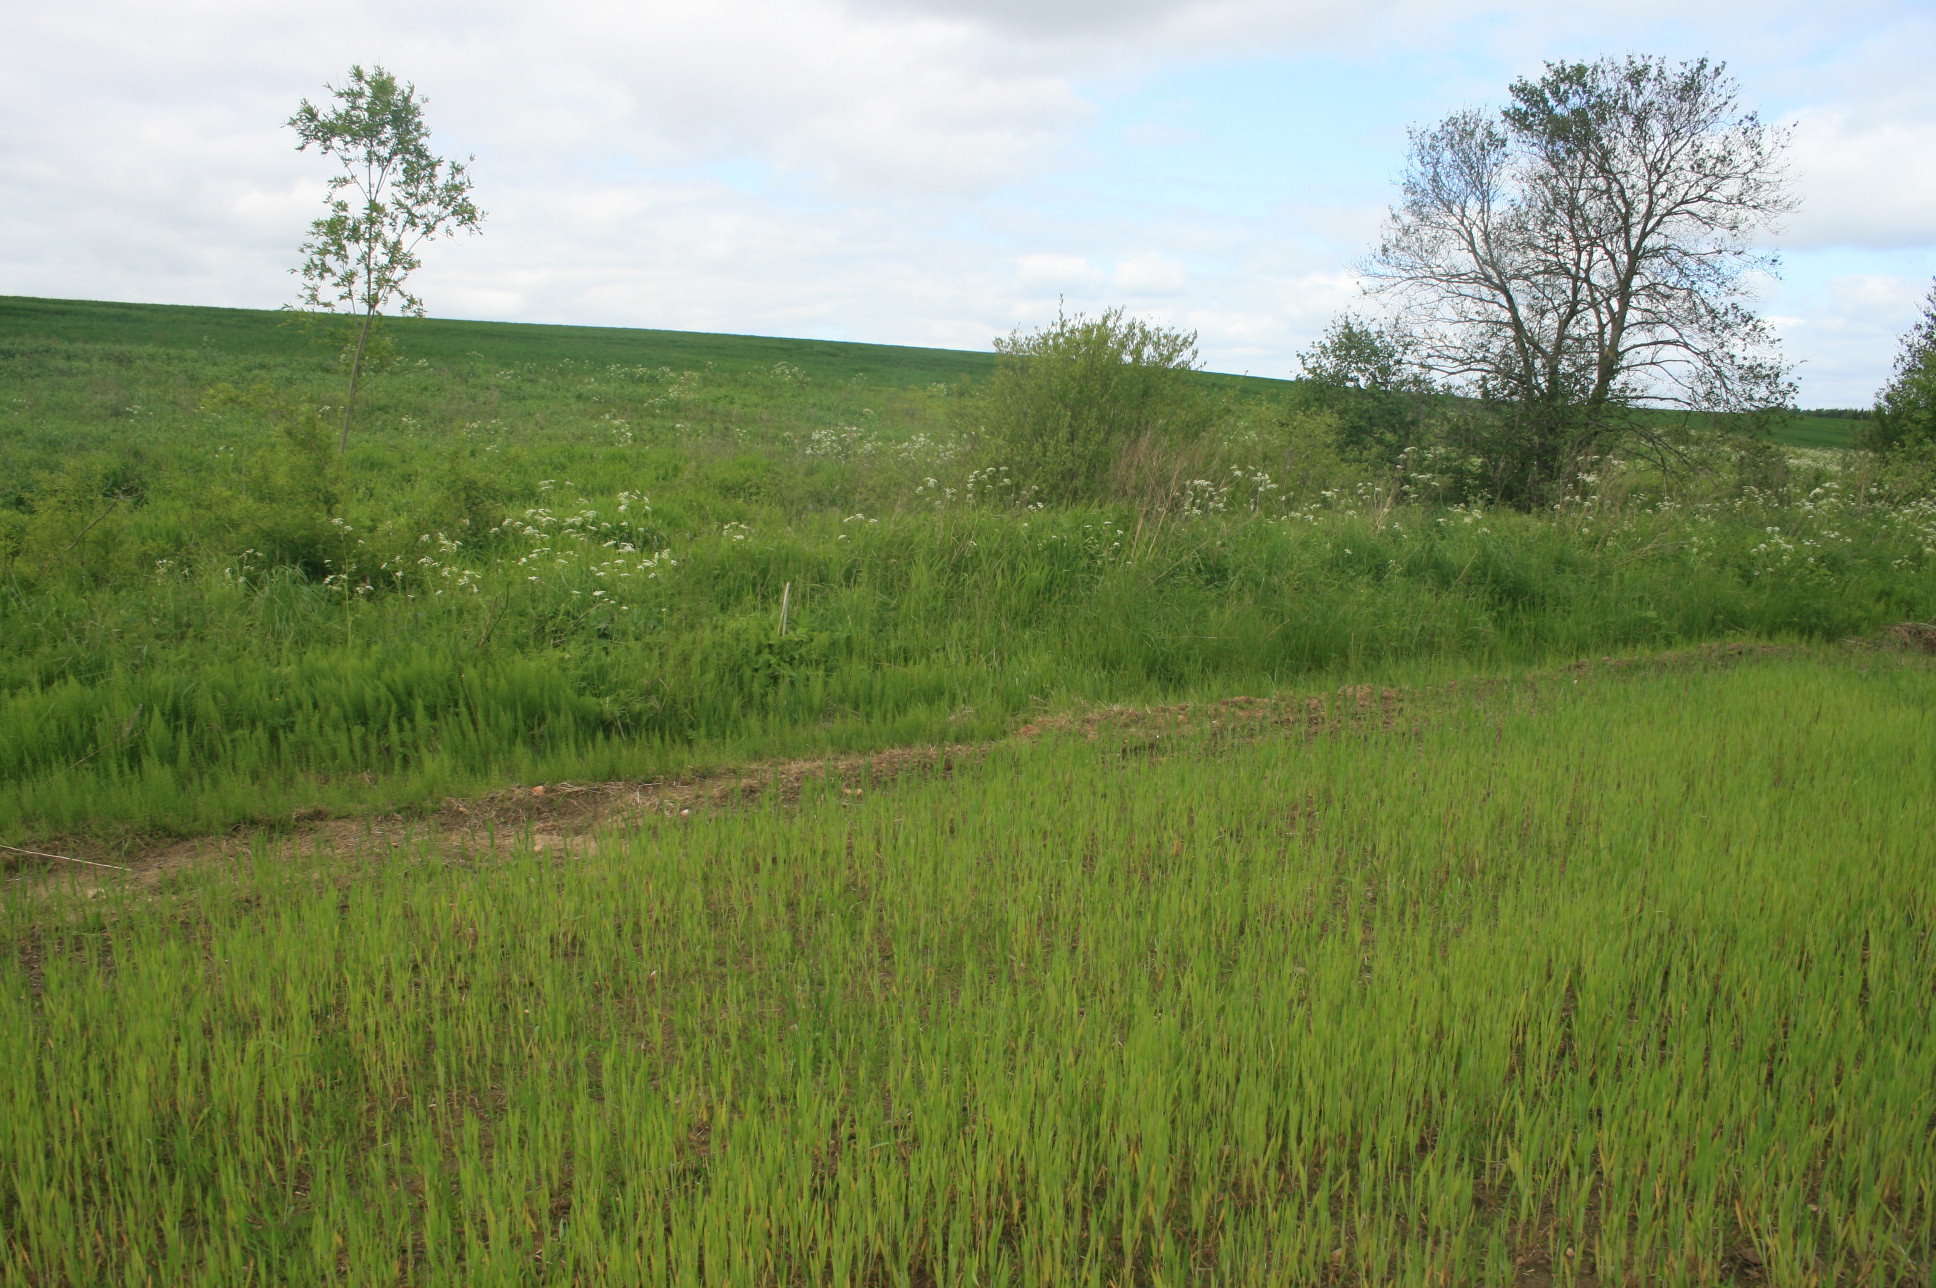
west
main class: Cropland
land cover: Rye
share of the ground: 50 - 75 %
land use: Agriculture (excluding fallow land and kitchen gardens)
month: June
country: LT
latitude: 56.2600
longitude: 22.3736
